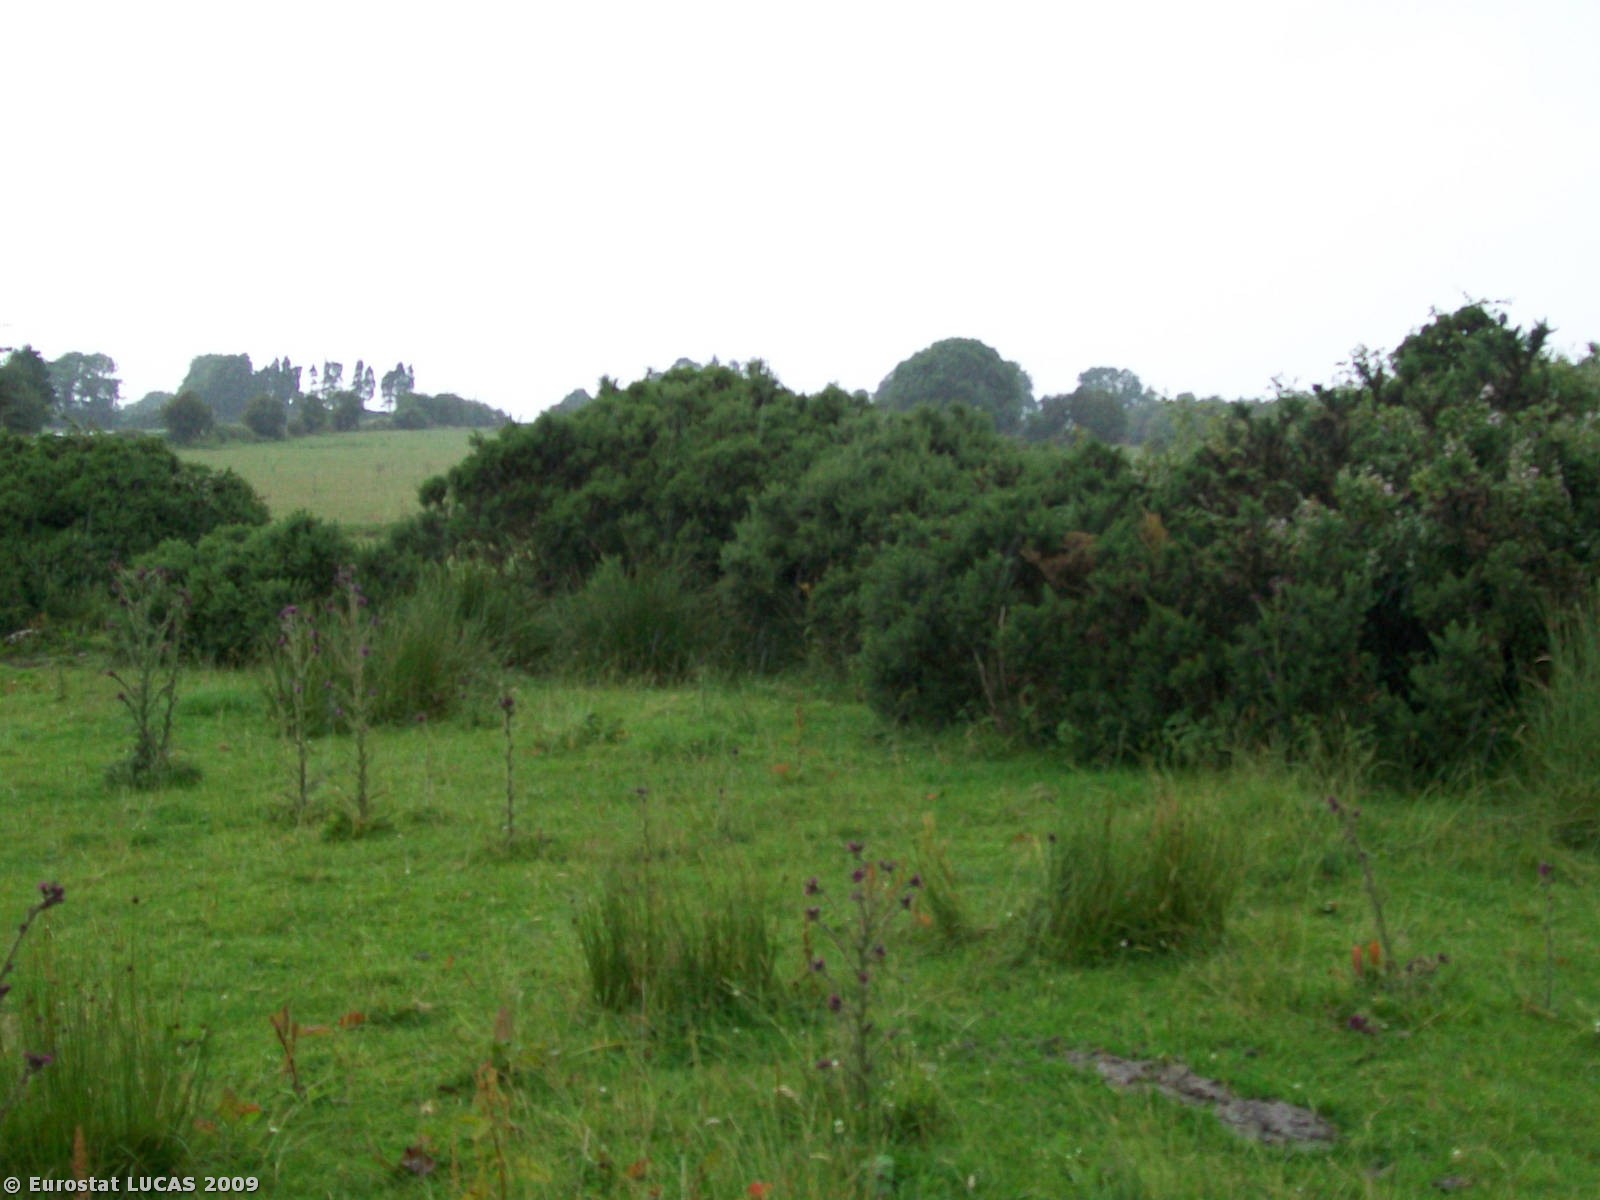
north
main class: Grassland
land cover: Grassland without tree/shrub cover
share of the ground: > 75 %
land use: Agriculture (excluding fallow land and kitchen gardens)
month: July
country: IE
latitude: 53.6255
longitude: -8.9439
